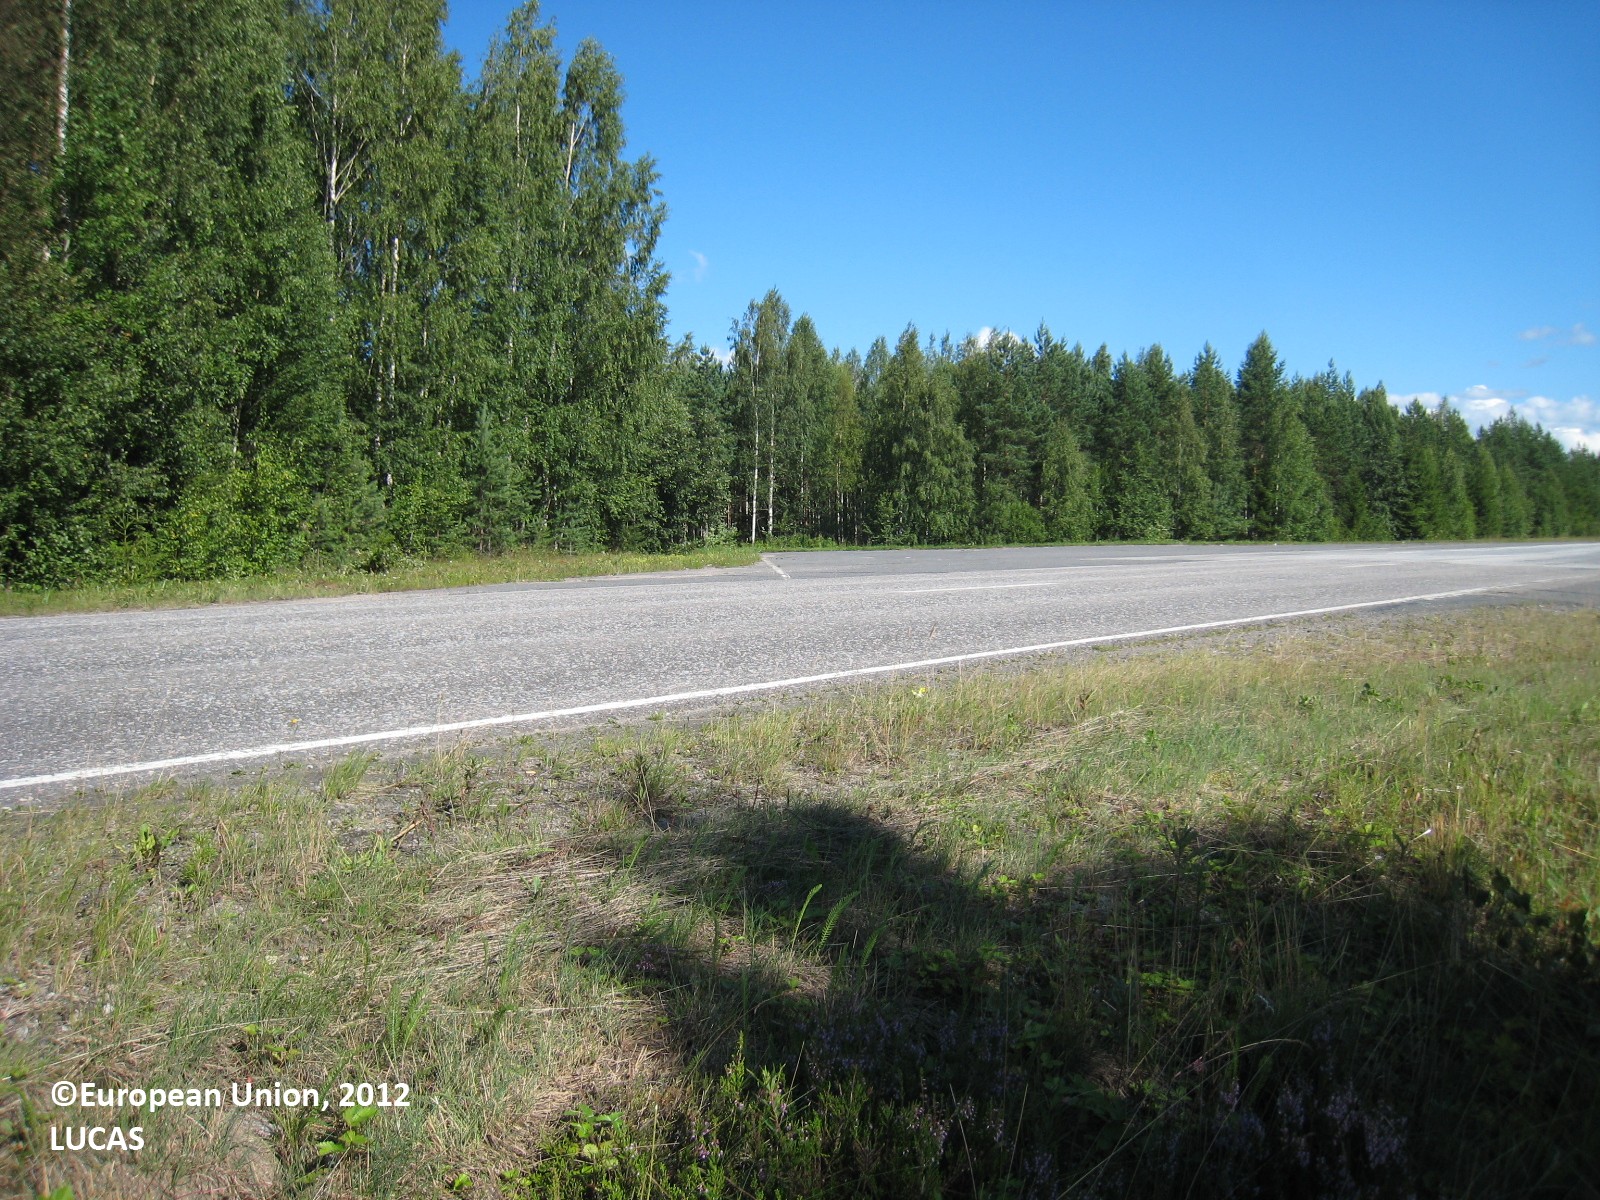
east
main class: Grassland
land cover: Grassland with sparse tree/shrub cover
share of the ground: > 75 %
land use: Road transport
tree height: < 5 m
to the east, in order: Grassland with sparse tree/shrub cover; Paved roads, cycling and walking lanes; Artificial constructions in urban areas; Grassland without tree/shrub cover; Artificial constructions in urban areas; Grassland without tree/shrub cover; Pine dominated mixed woodland; Other mixed woodland; Spruce dominated mixed woodland
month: July
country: FI
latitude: 62.9545
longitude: 26.7986
